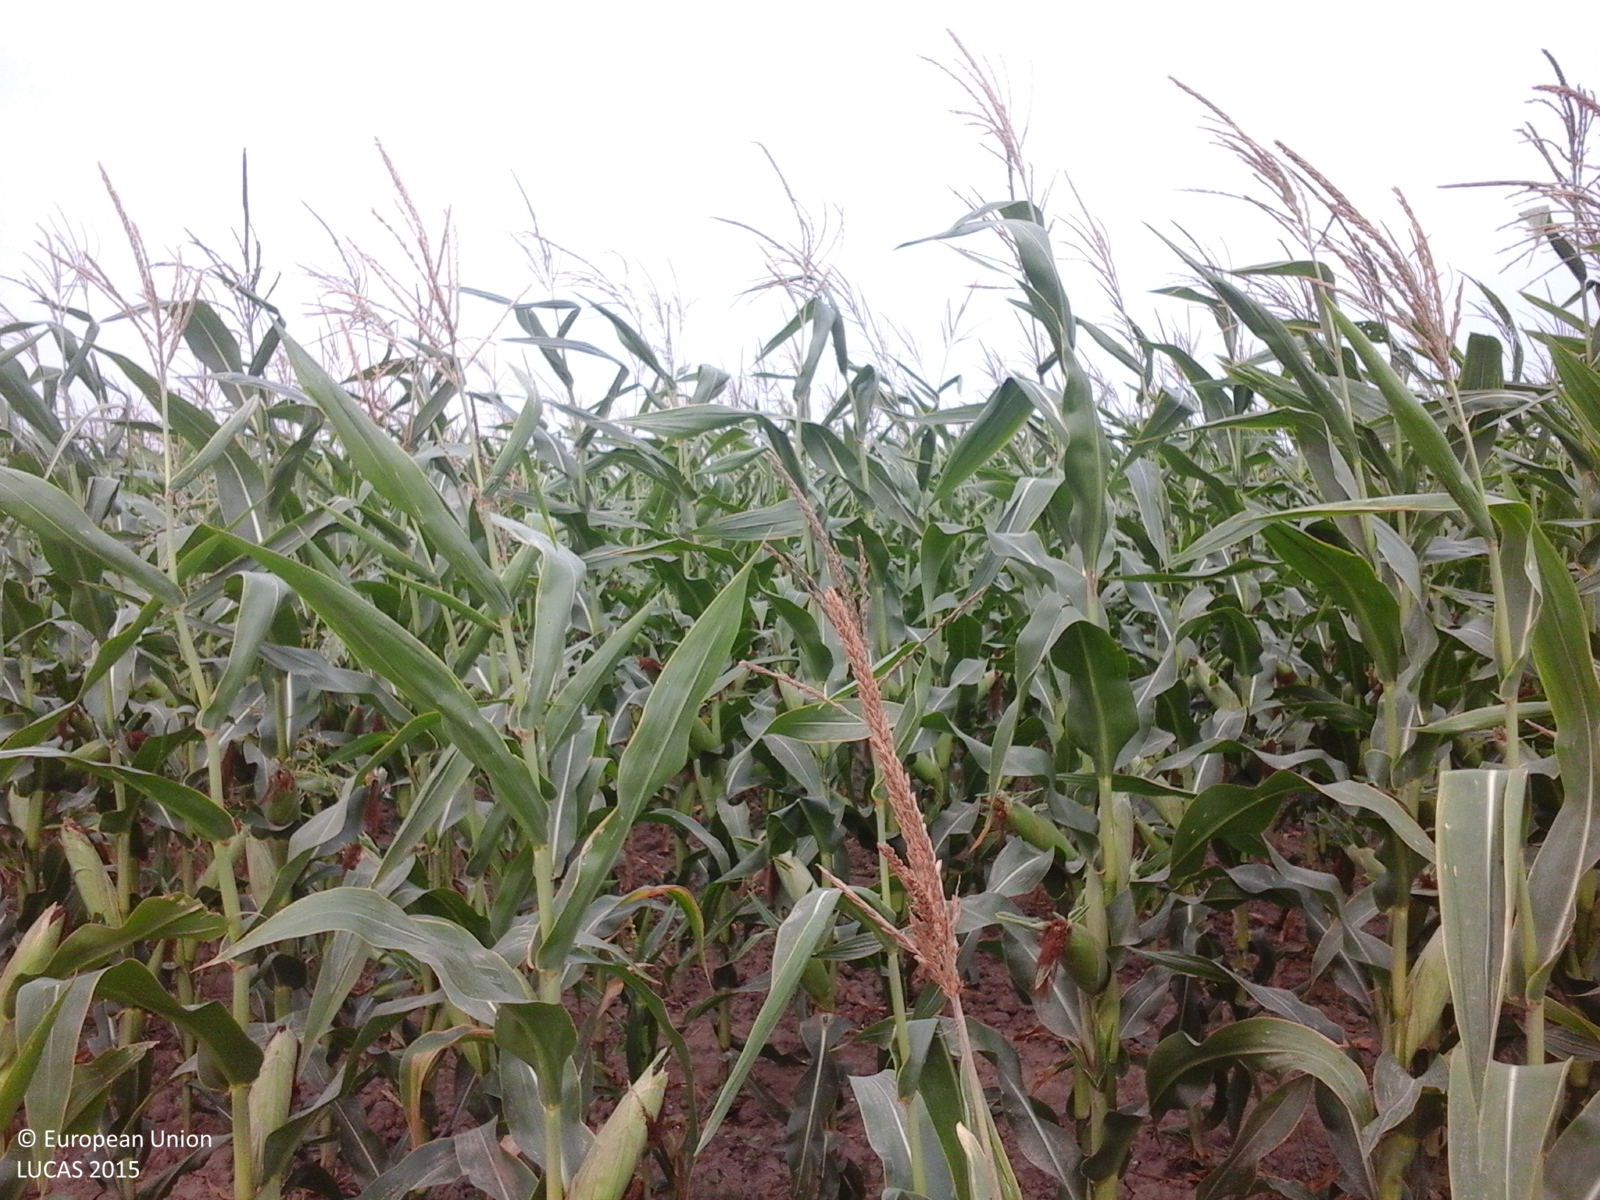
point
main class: Cropland
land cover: Maize
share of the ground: > 75 %
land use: Agriculture (excluding fallow land and kitchen gardens)
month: August
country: RO
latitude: 44.8686
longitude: 28.1786
